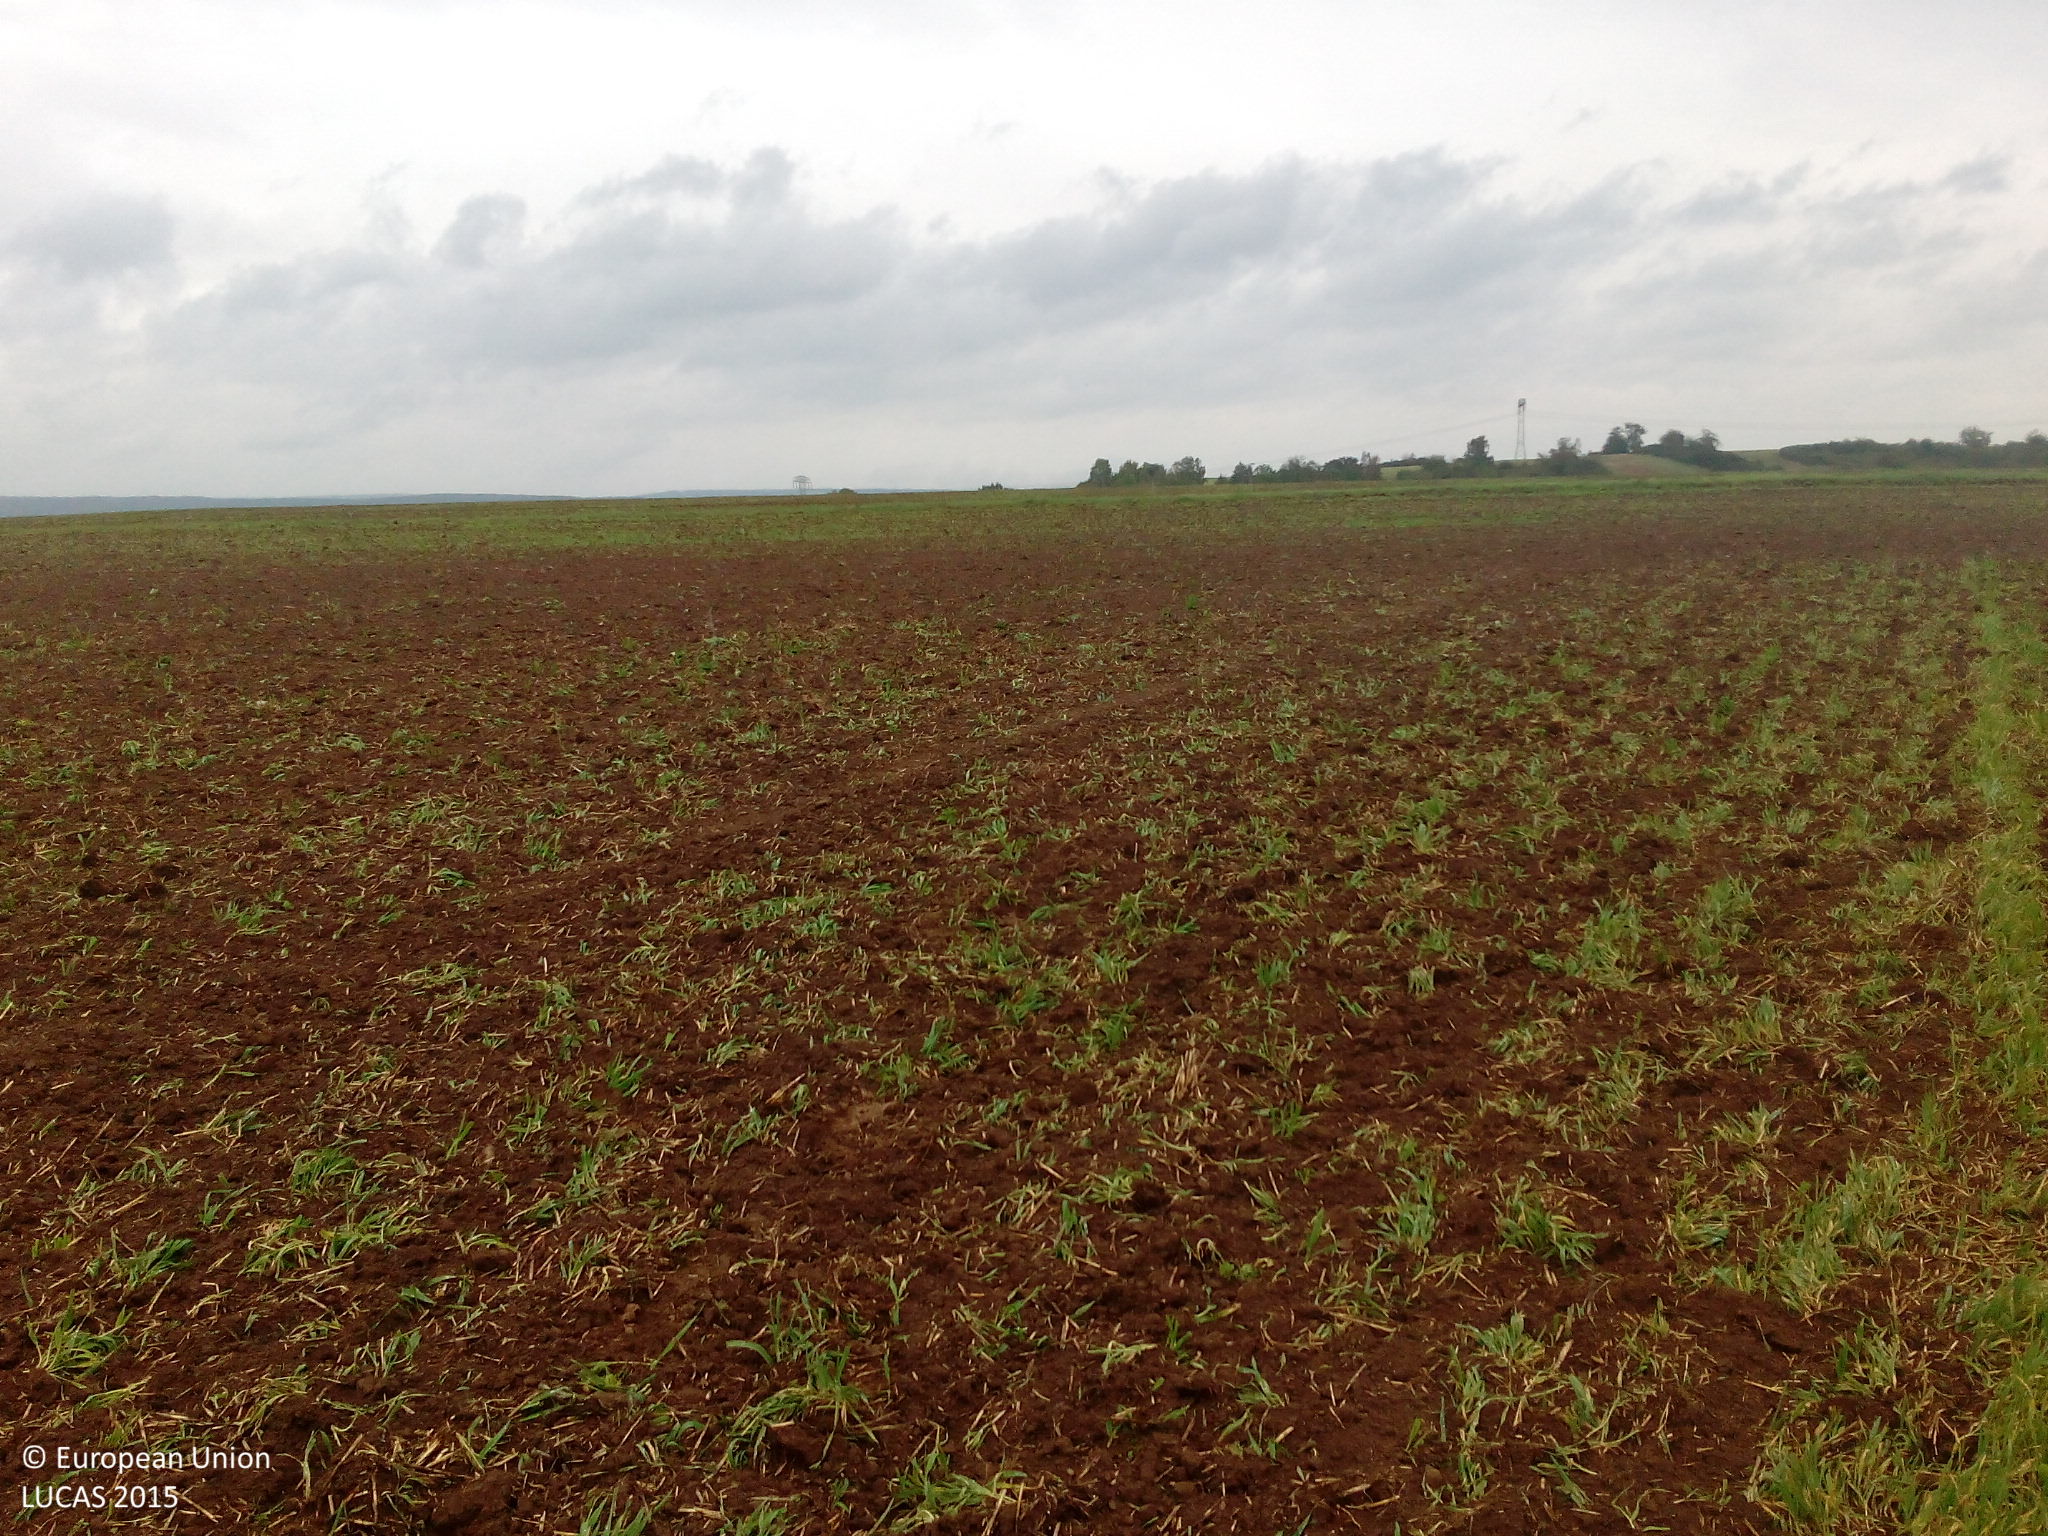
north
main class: Cropland
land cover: Barley
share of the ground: 10 - 25 %
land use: Agriculture (excluding fallow land and kitchen gardens)
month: September
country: DE
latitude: 51.4375
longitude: 11.1074
